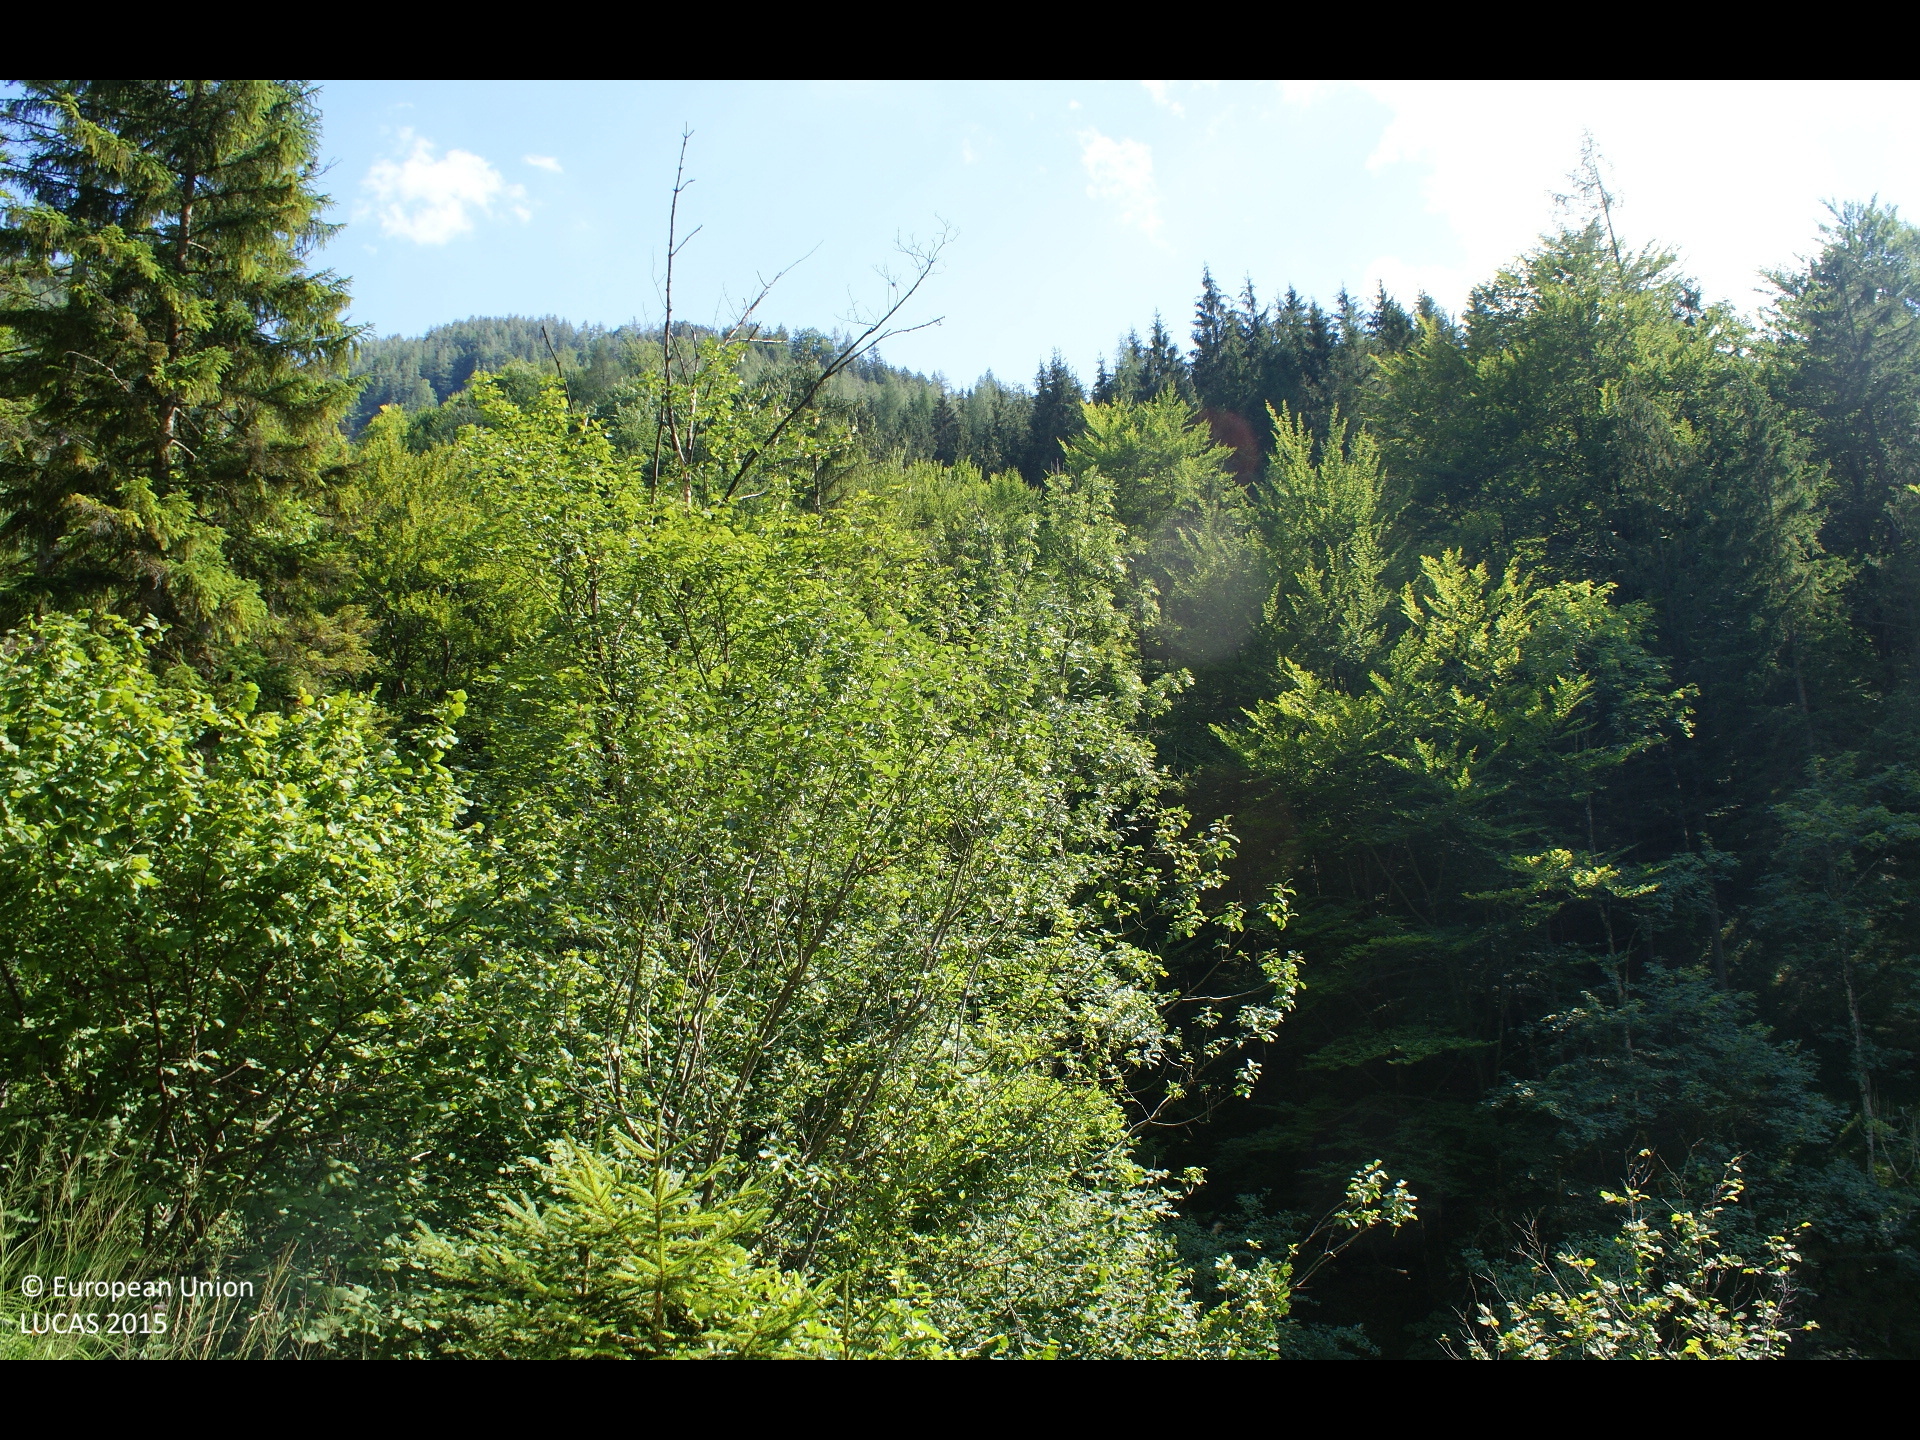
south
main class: Woodland
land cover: Spruce dominated mixed woodland
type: mesophytic deciduous forest
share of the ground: 50 - 75 %
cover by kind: coniferous forest trees 35 %, herbaceous plants 35 %, broadleaved forest trees 20 %, shrubs 5 %
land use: Forestry
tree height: > 5 m
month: July
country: AT
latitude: 47.7589
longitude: 14.7894
